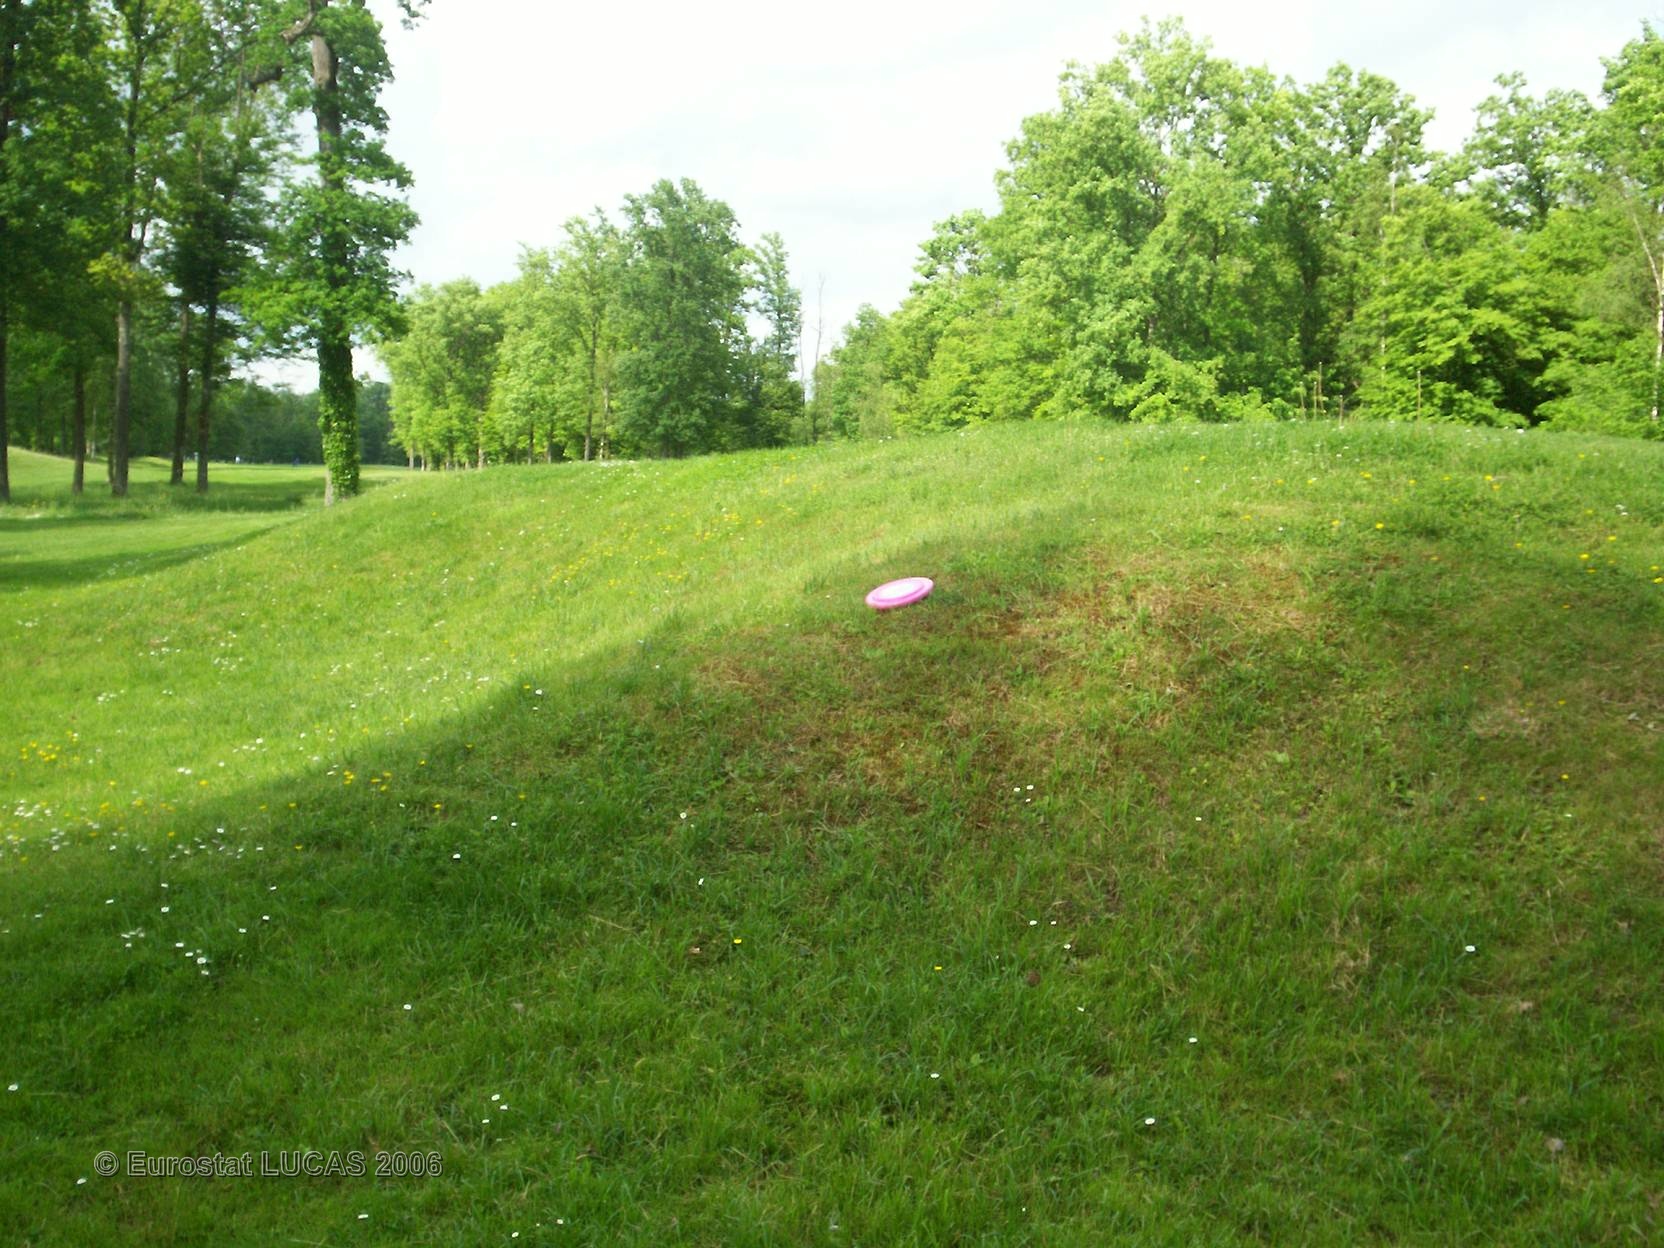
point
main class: Grassland
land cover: Grassland without tree/shrub cover
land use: Sport
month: May
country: FR
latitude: 48.7411
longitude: 2.7149
